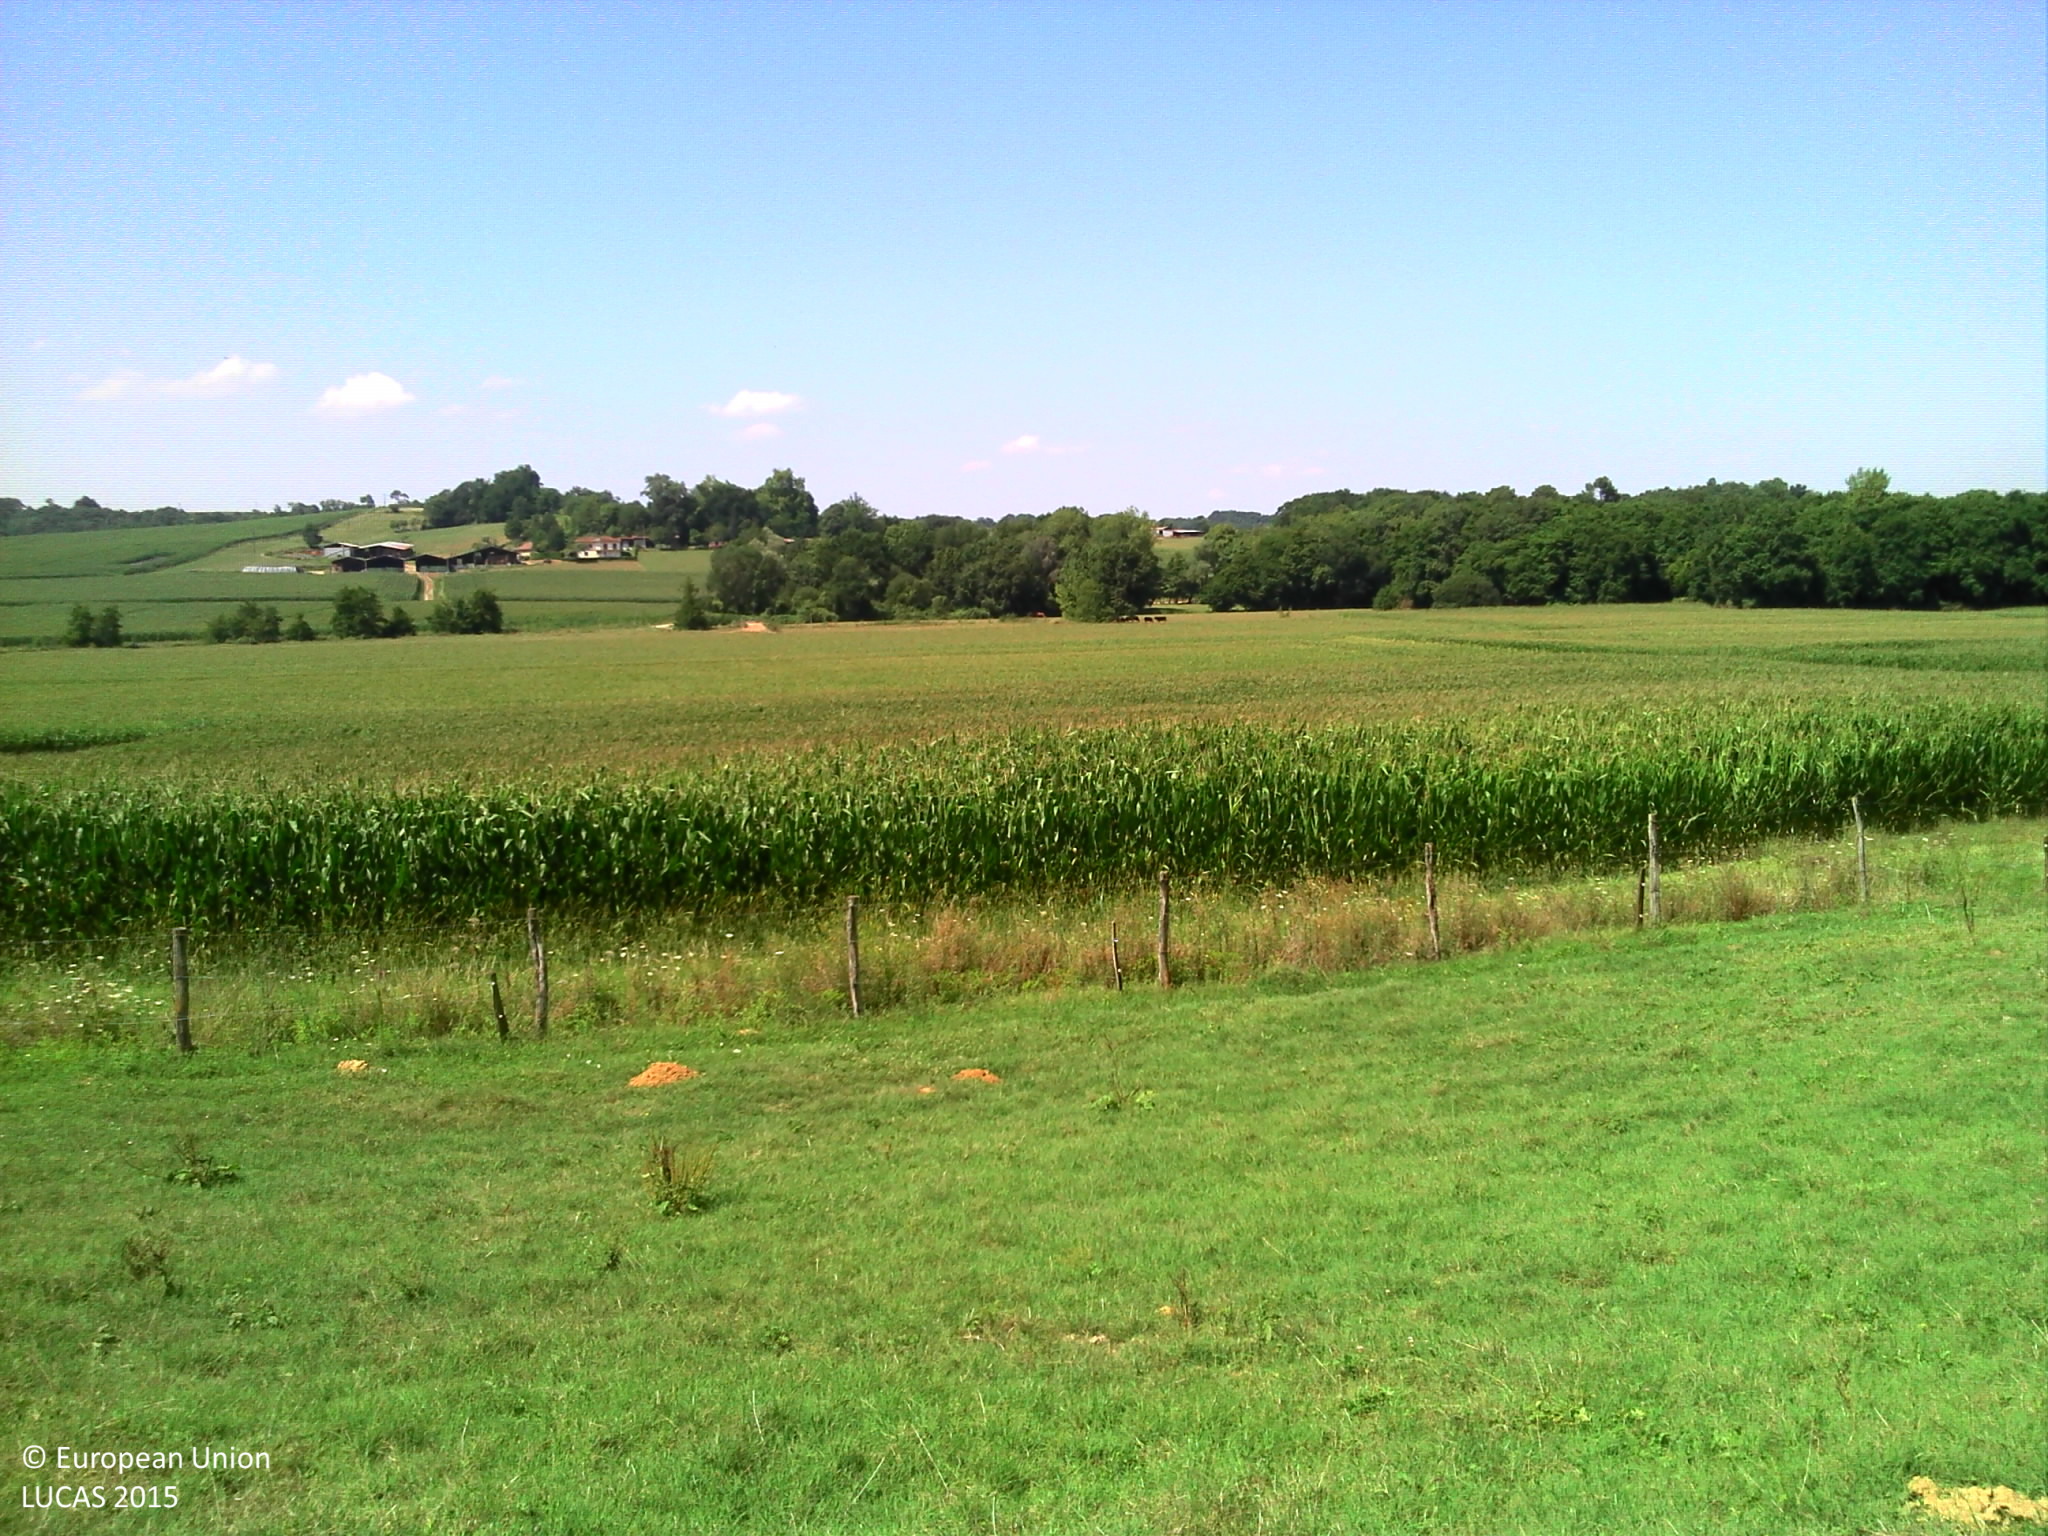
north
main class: Grassland
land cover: Grassland without tree/shrub cover
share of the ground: > 75 %
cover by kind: herbaceous plants 95 %, unconsolidated bare surface 5 %
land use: Agriculture (excluding fallow land and kitchen gardens)
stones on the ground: < 10 %
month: August
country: FR
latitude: 43.7204
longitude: -0.7249
